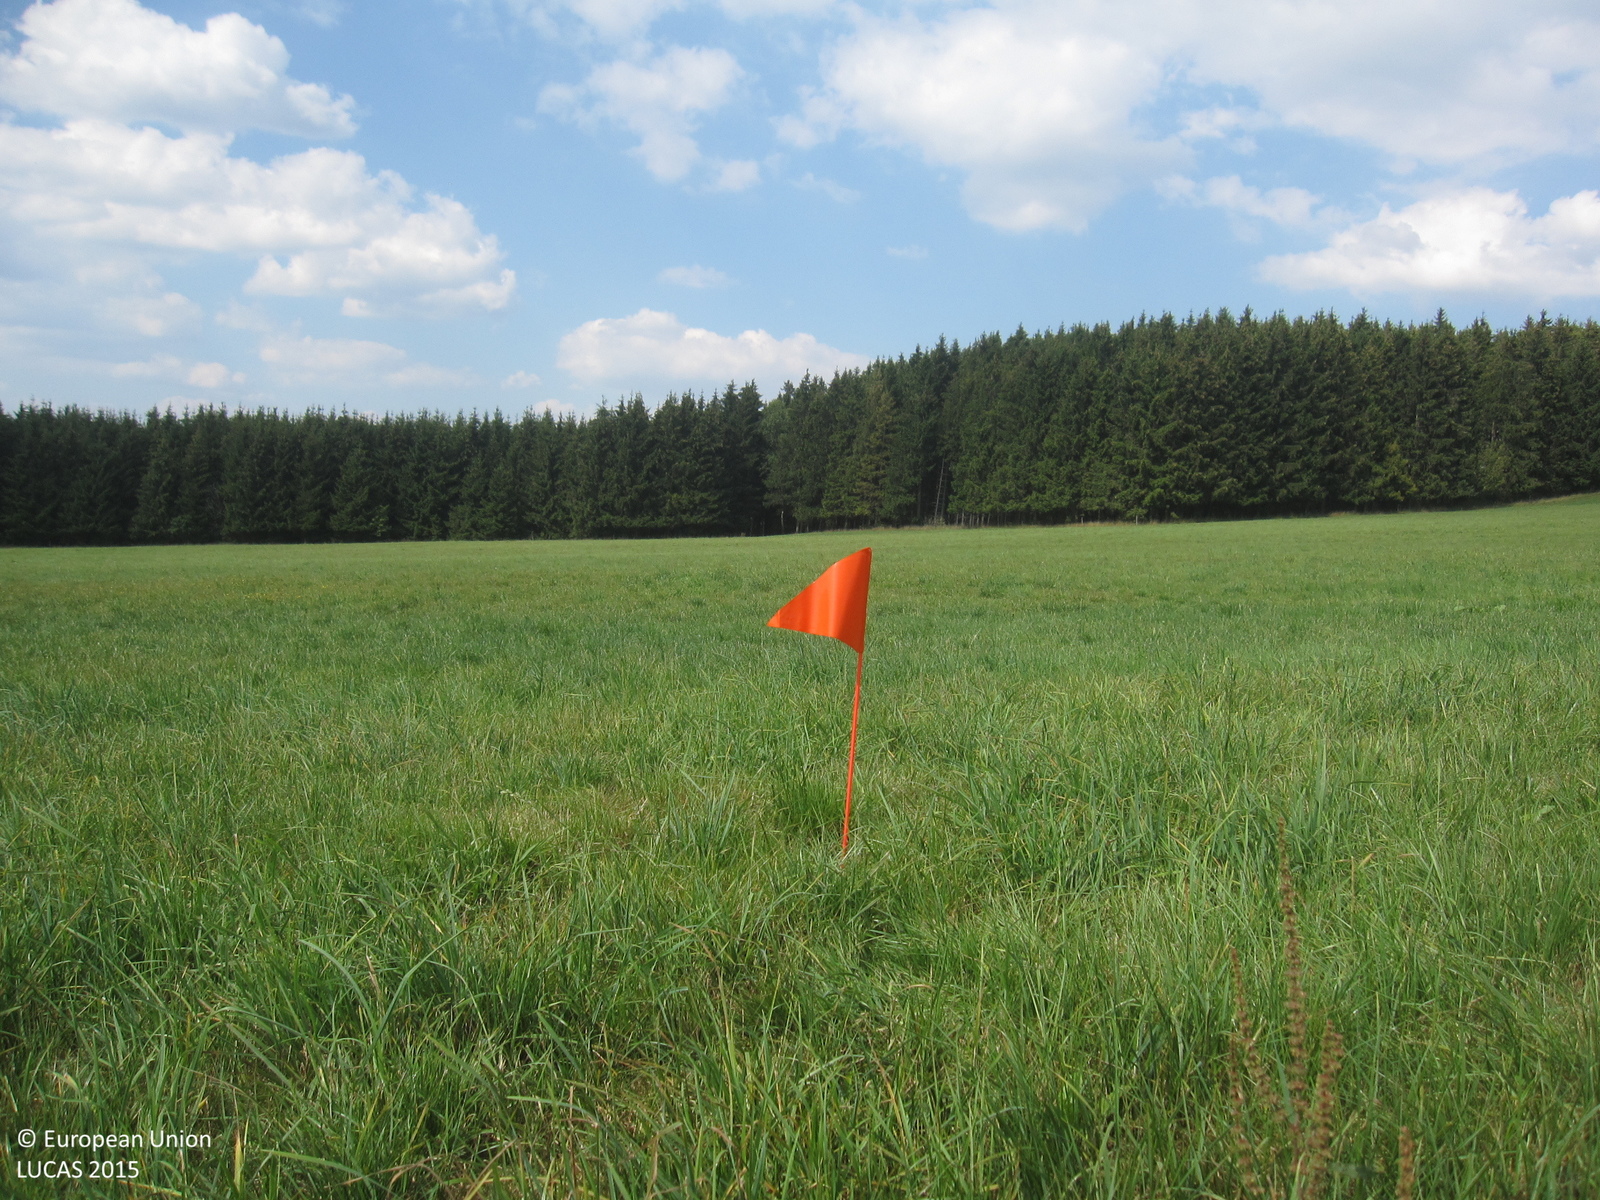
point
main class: Grassland
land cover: Grassland without tree/shrub cover
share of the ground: > 75 %
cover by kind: herbaceous plants 95 %, unconsolidated bare surface 5 %
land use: Agriculture (excluding fallow land and kitchen gardens)
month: August
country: DE
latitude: 50.4249
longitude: 11.5902
